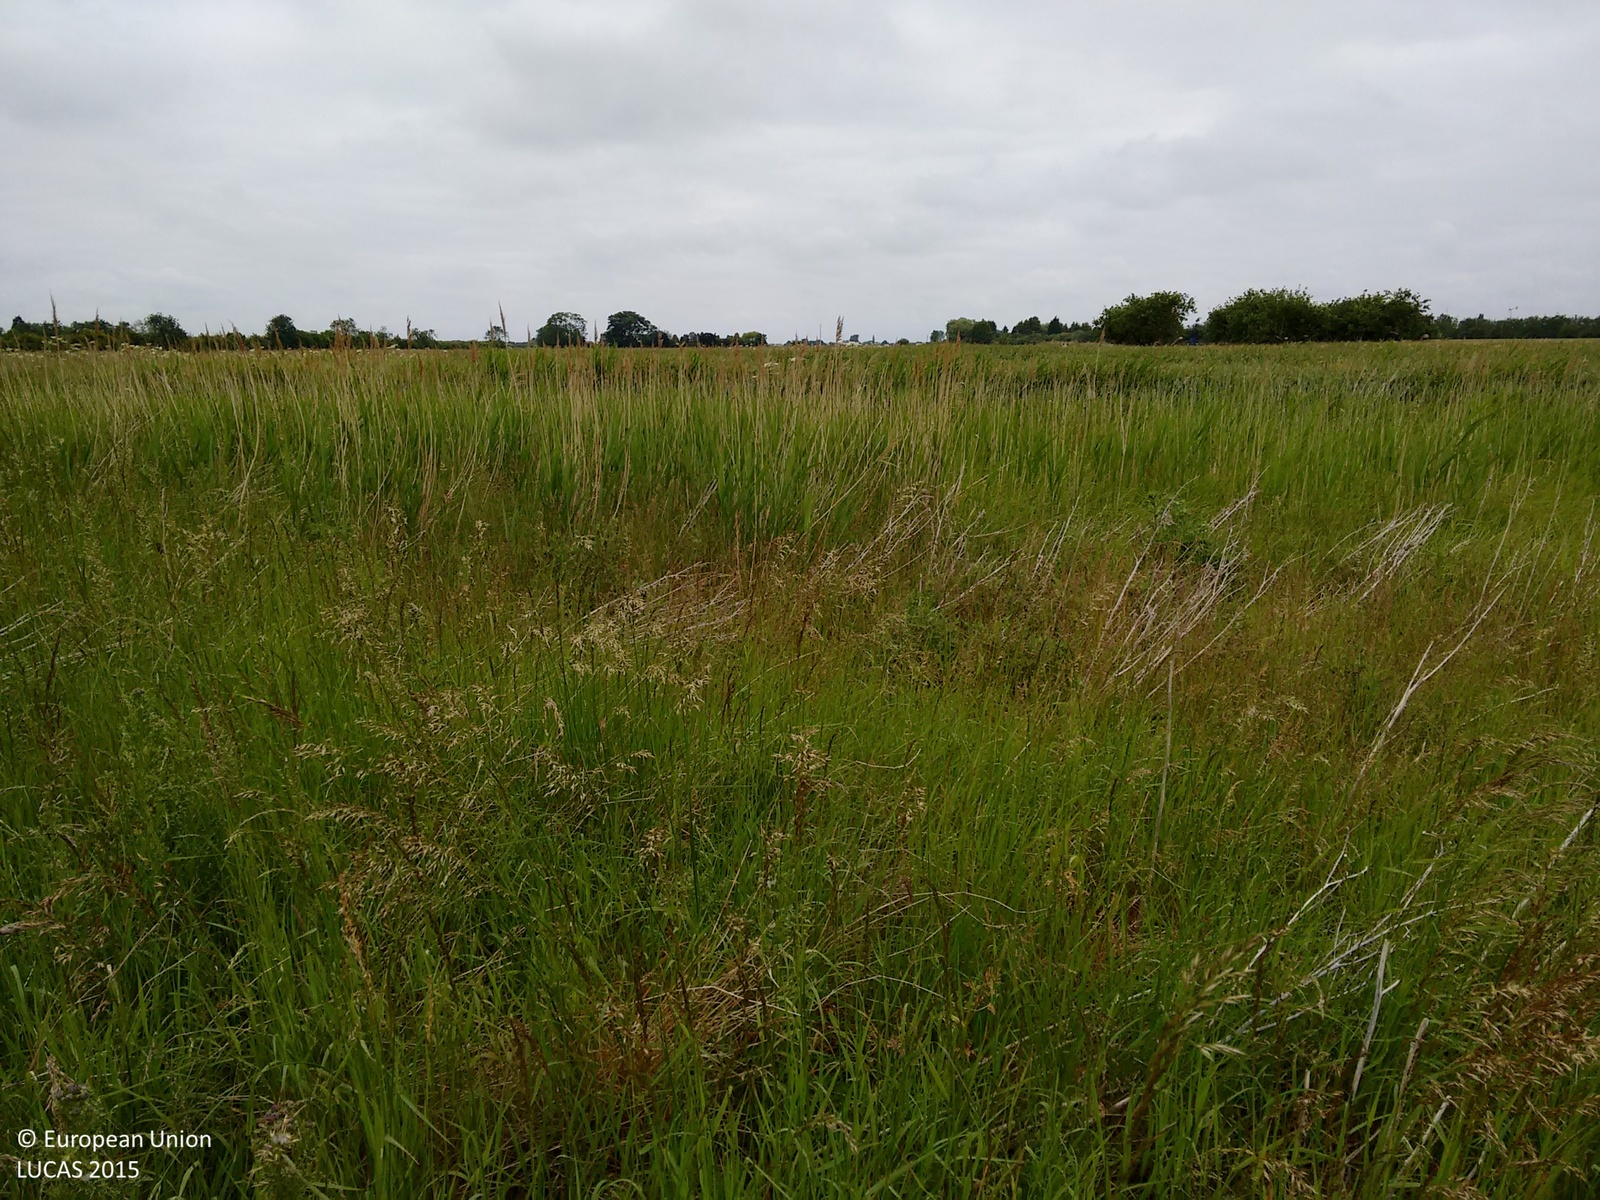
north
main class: Grassland
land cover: Grassland without tree/shrub cover
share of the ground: > 75 %
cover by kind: herbaceous plants 100 %
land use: Sport
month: June
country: GB
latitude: 52.7351
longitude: 0.2399
